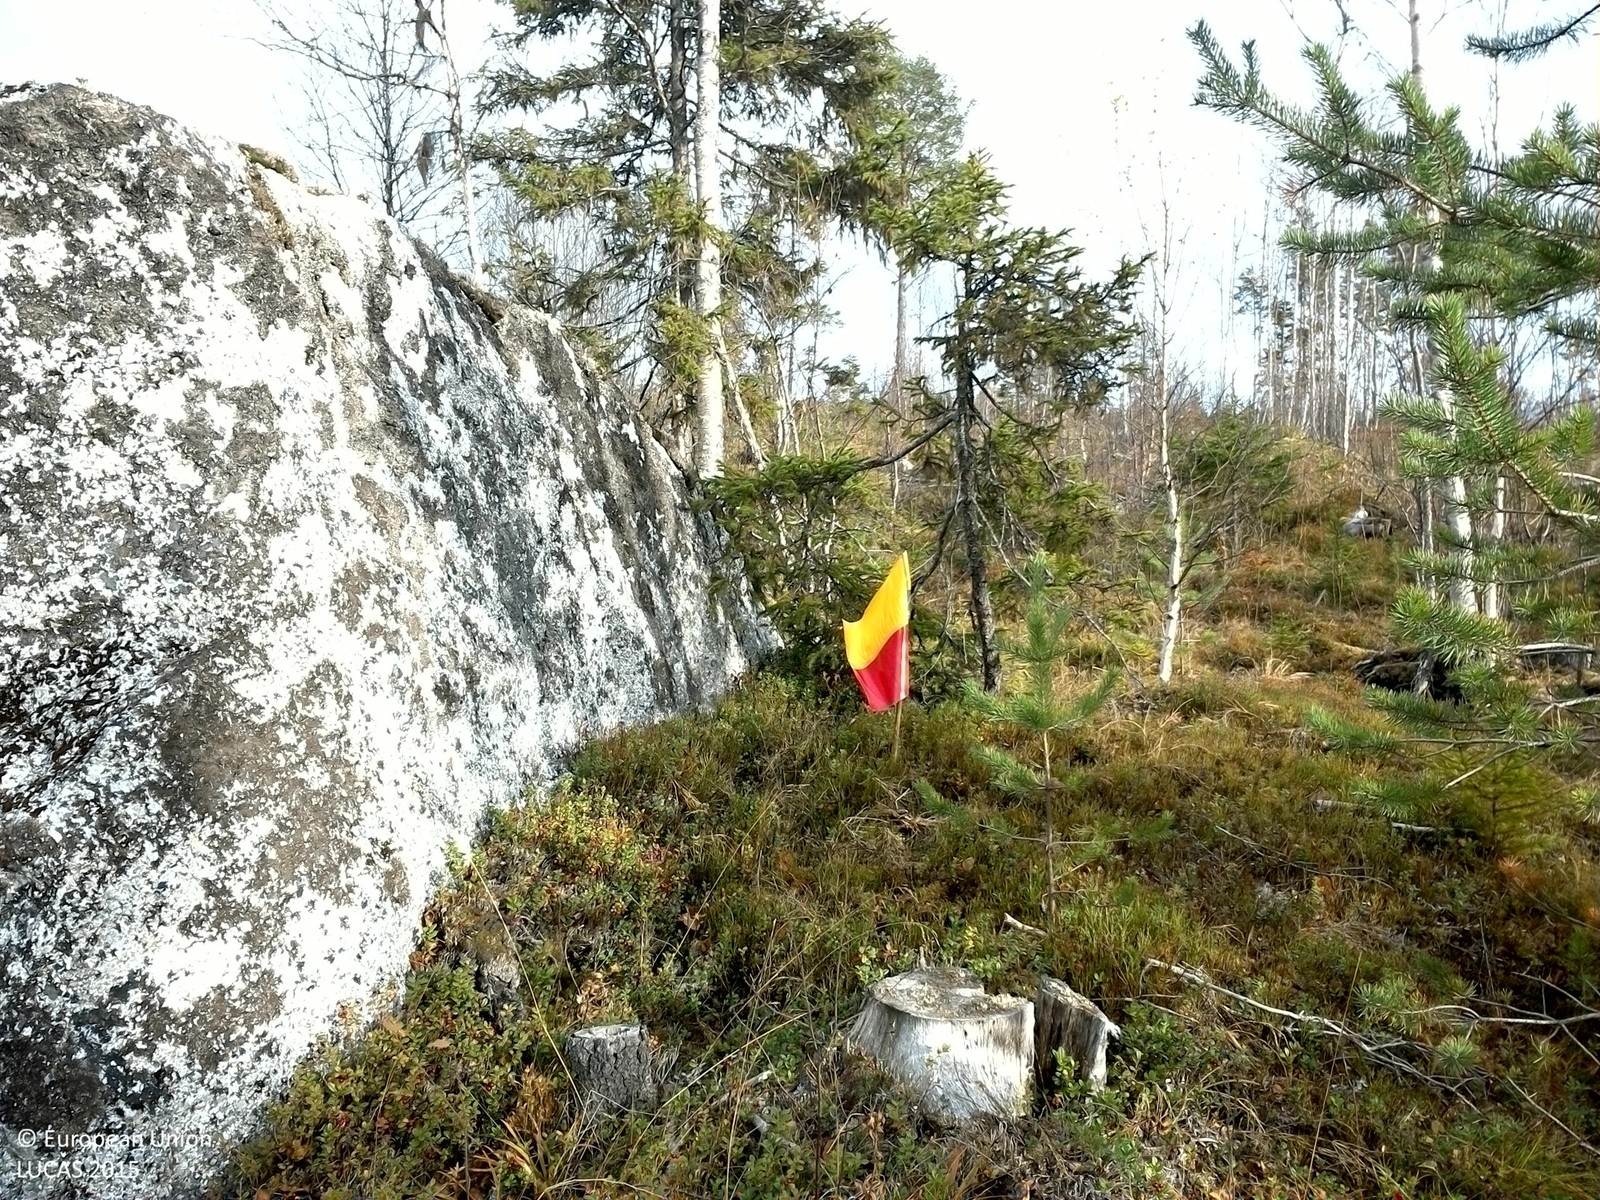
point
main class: Woodland
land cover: Spruce dominated mixed woodland
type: boreal forest
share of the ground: 25 - 50 %
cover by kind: shrubs 40 %, broadleaved forest trees 15 %, lichens and mosses 15 %, coniferous forest trees 10 %, herbaceous plants 10 %, consolidated bare surface 10 %
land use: Forestry
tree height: < 5 m
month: October
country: SE
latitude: 64.0159
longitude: 15.9248
